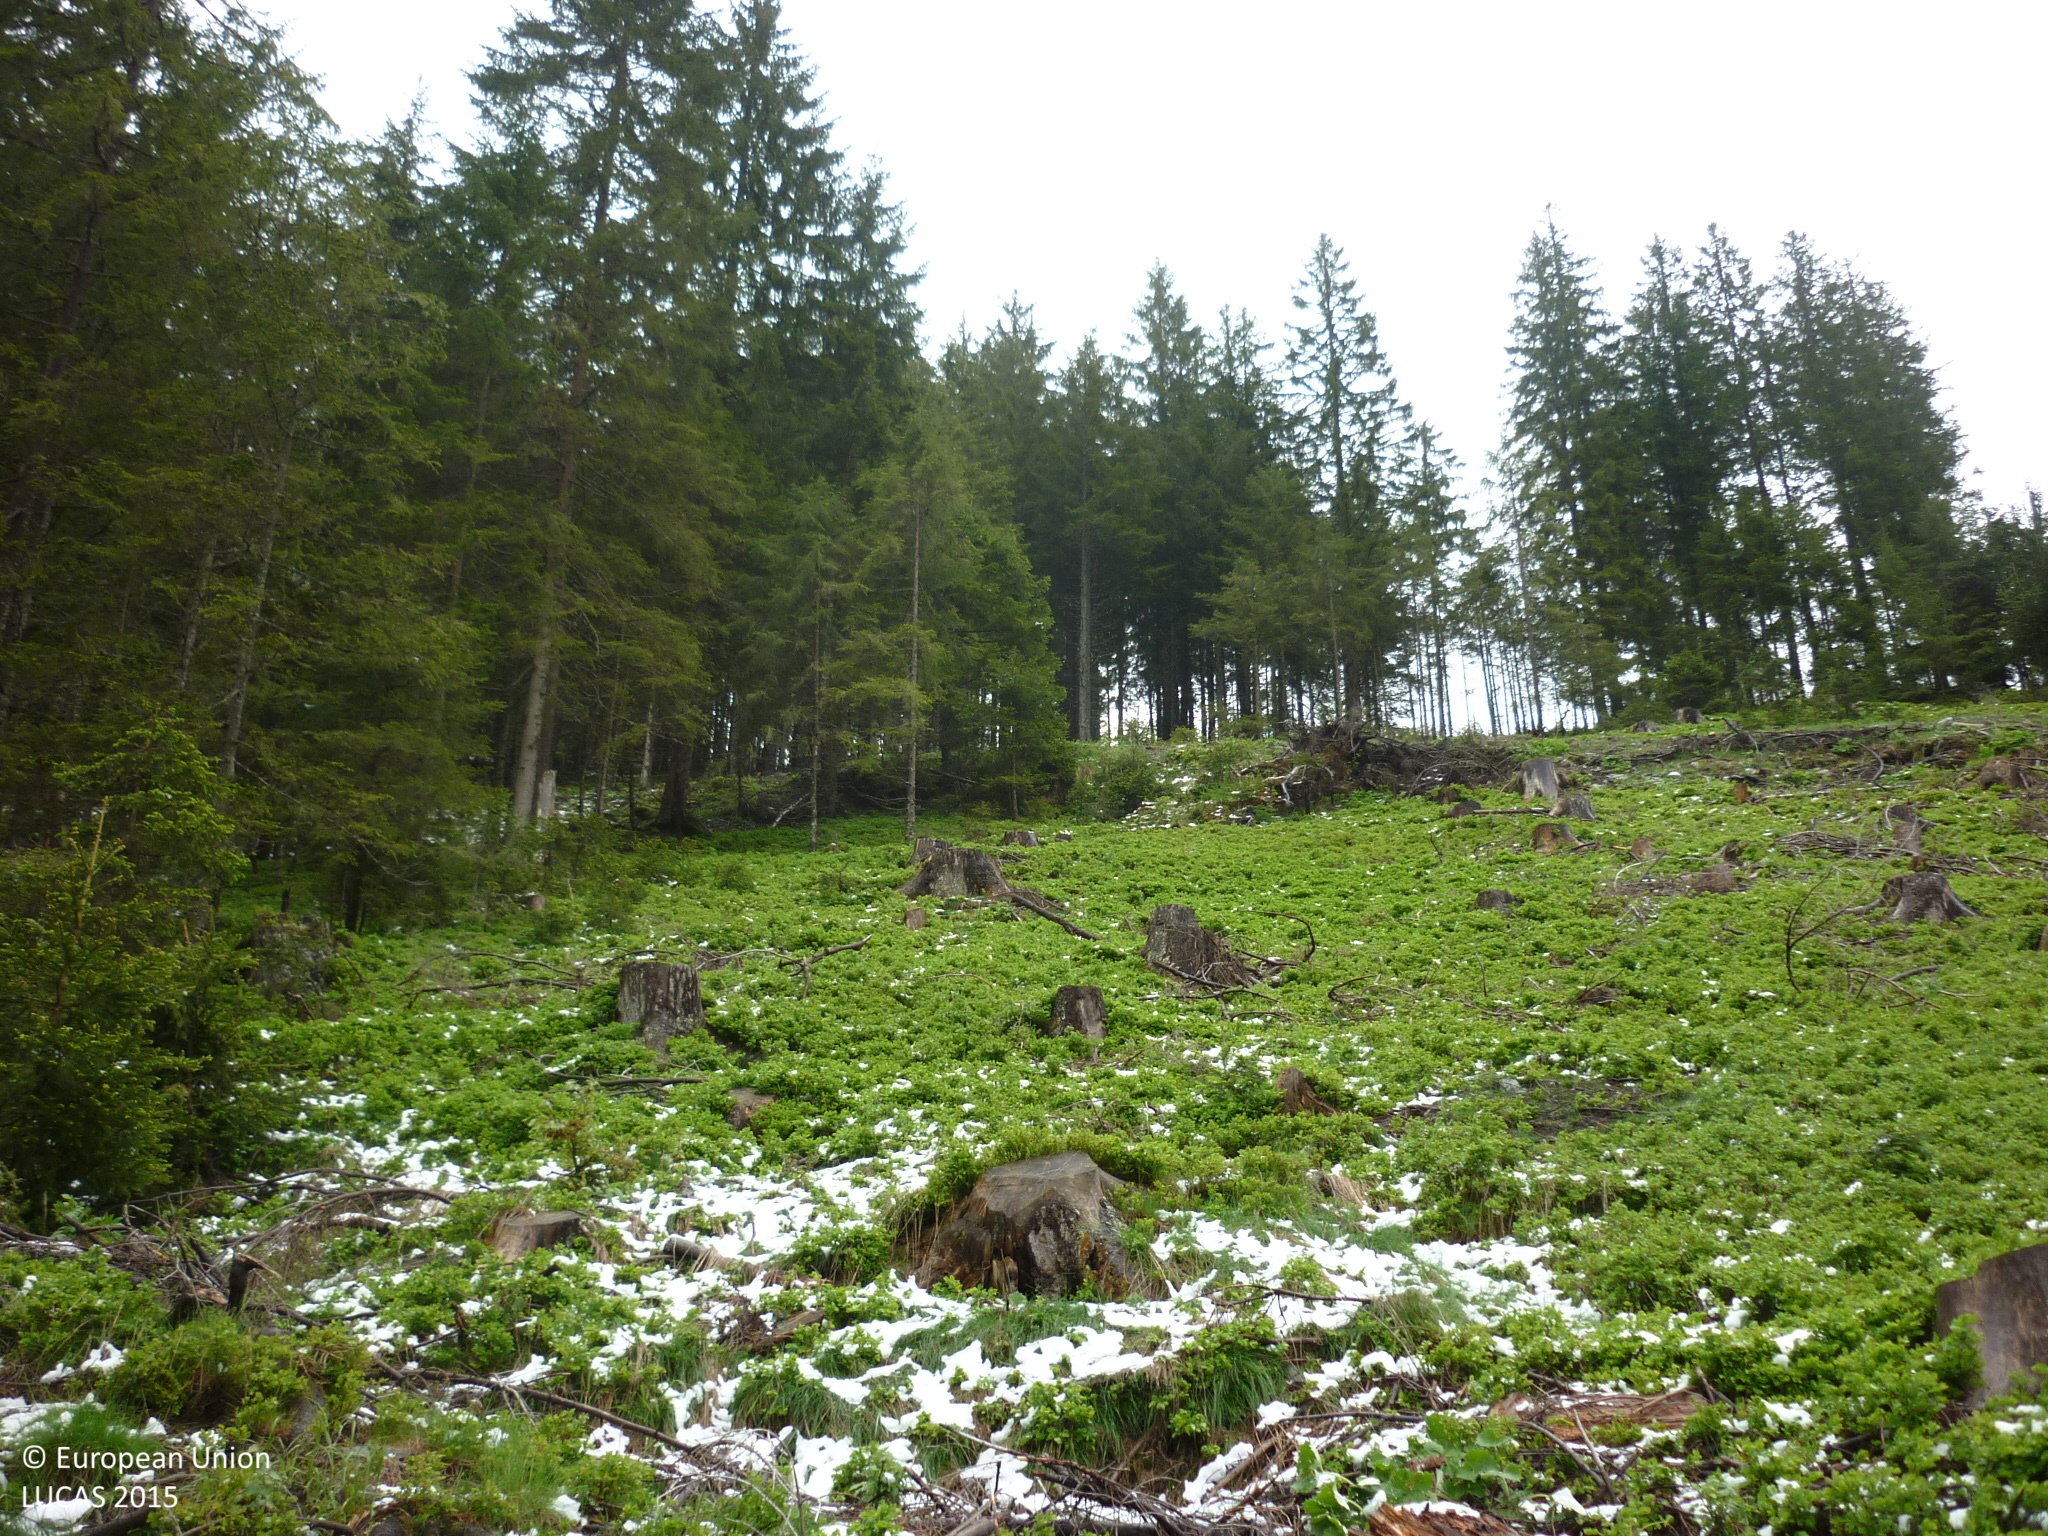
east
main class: Shrubland
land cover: Shrubland with sparse tree cover
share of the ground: > 75 %
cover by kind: shrubs 80 %, herbaceous plants 15 %, coniferous forest trees 5 %
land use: Forestry
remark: Clear cut
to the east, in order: Shrubland with sparse tree cover; Spruce dominated coniferous woodland; Tracks; Spruce dominated coniferous woodland; Tracks; Spruce dominated mixed woodland
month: May
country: AT
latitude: 47.4459
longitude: 14.5213
